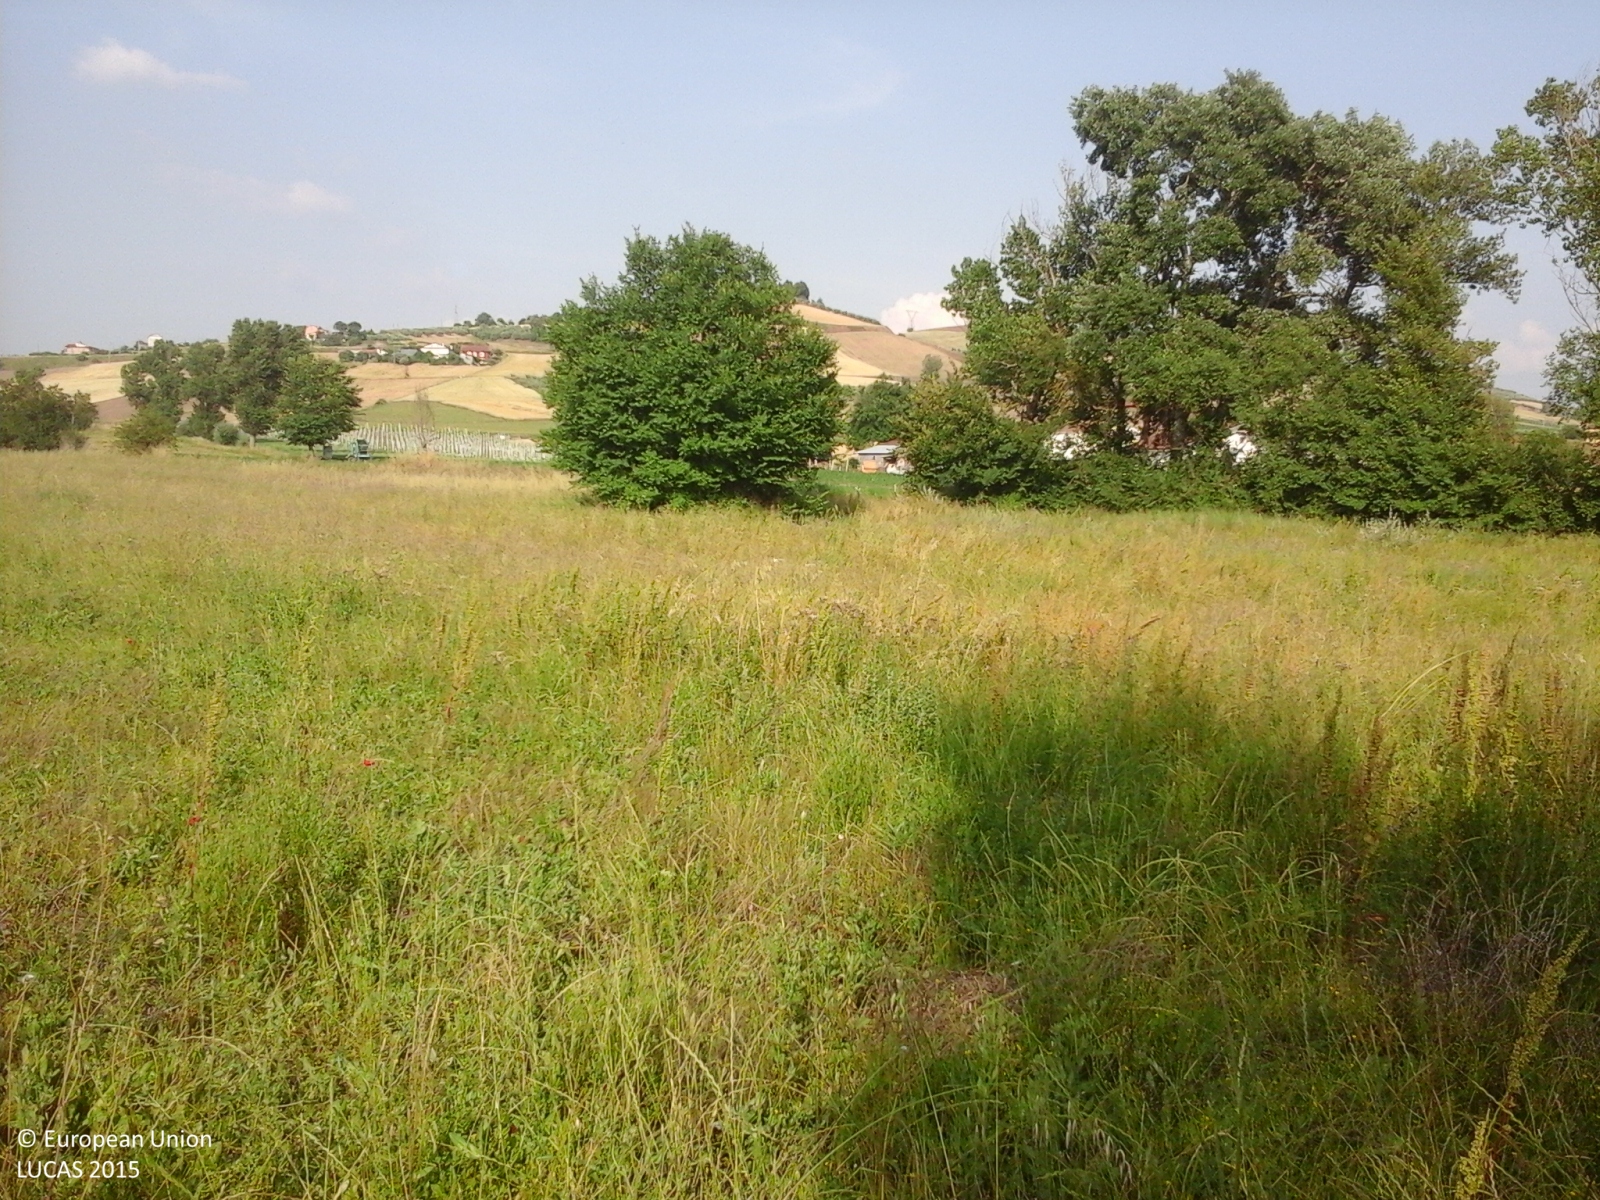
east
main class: Grassland
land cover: Spontaneously vegetated surfaces
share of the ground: > 75 %
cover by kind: herbaceous plants 100 %
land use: Fallow land
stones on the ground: < 10 %
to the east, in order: Spontaneously vegetated surfaces; Lucerne; Ditches and canals; Lucerne; Other fresh vegetables; Tomatoes; Other fresh vegetables; Maize; Tracks; Vineyards; Tracks; Grassland without tree/shrub cover; Artificial constructions in urban areas
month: June
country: IT
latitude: 41.0766
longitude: 15.1108
